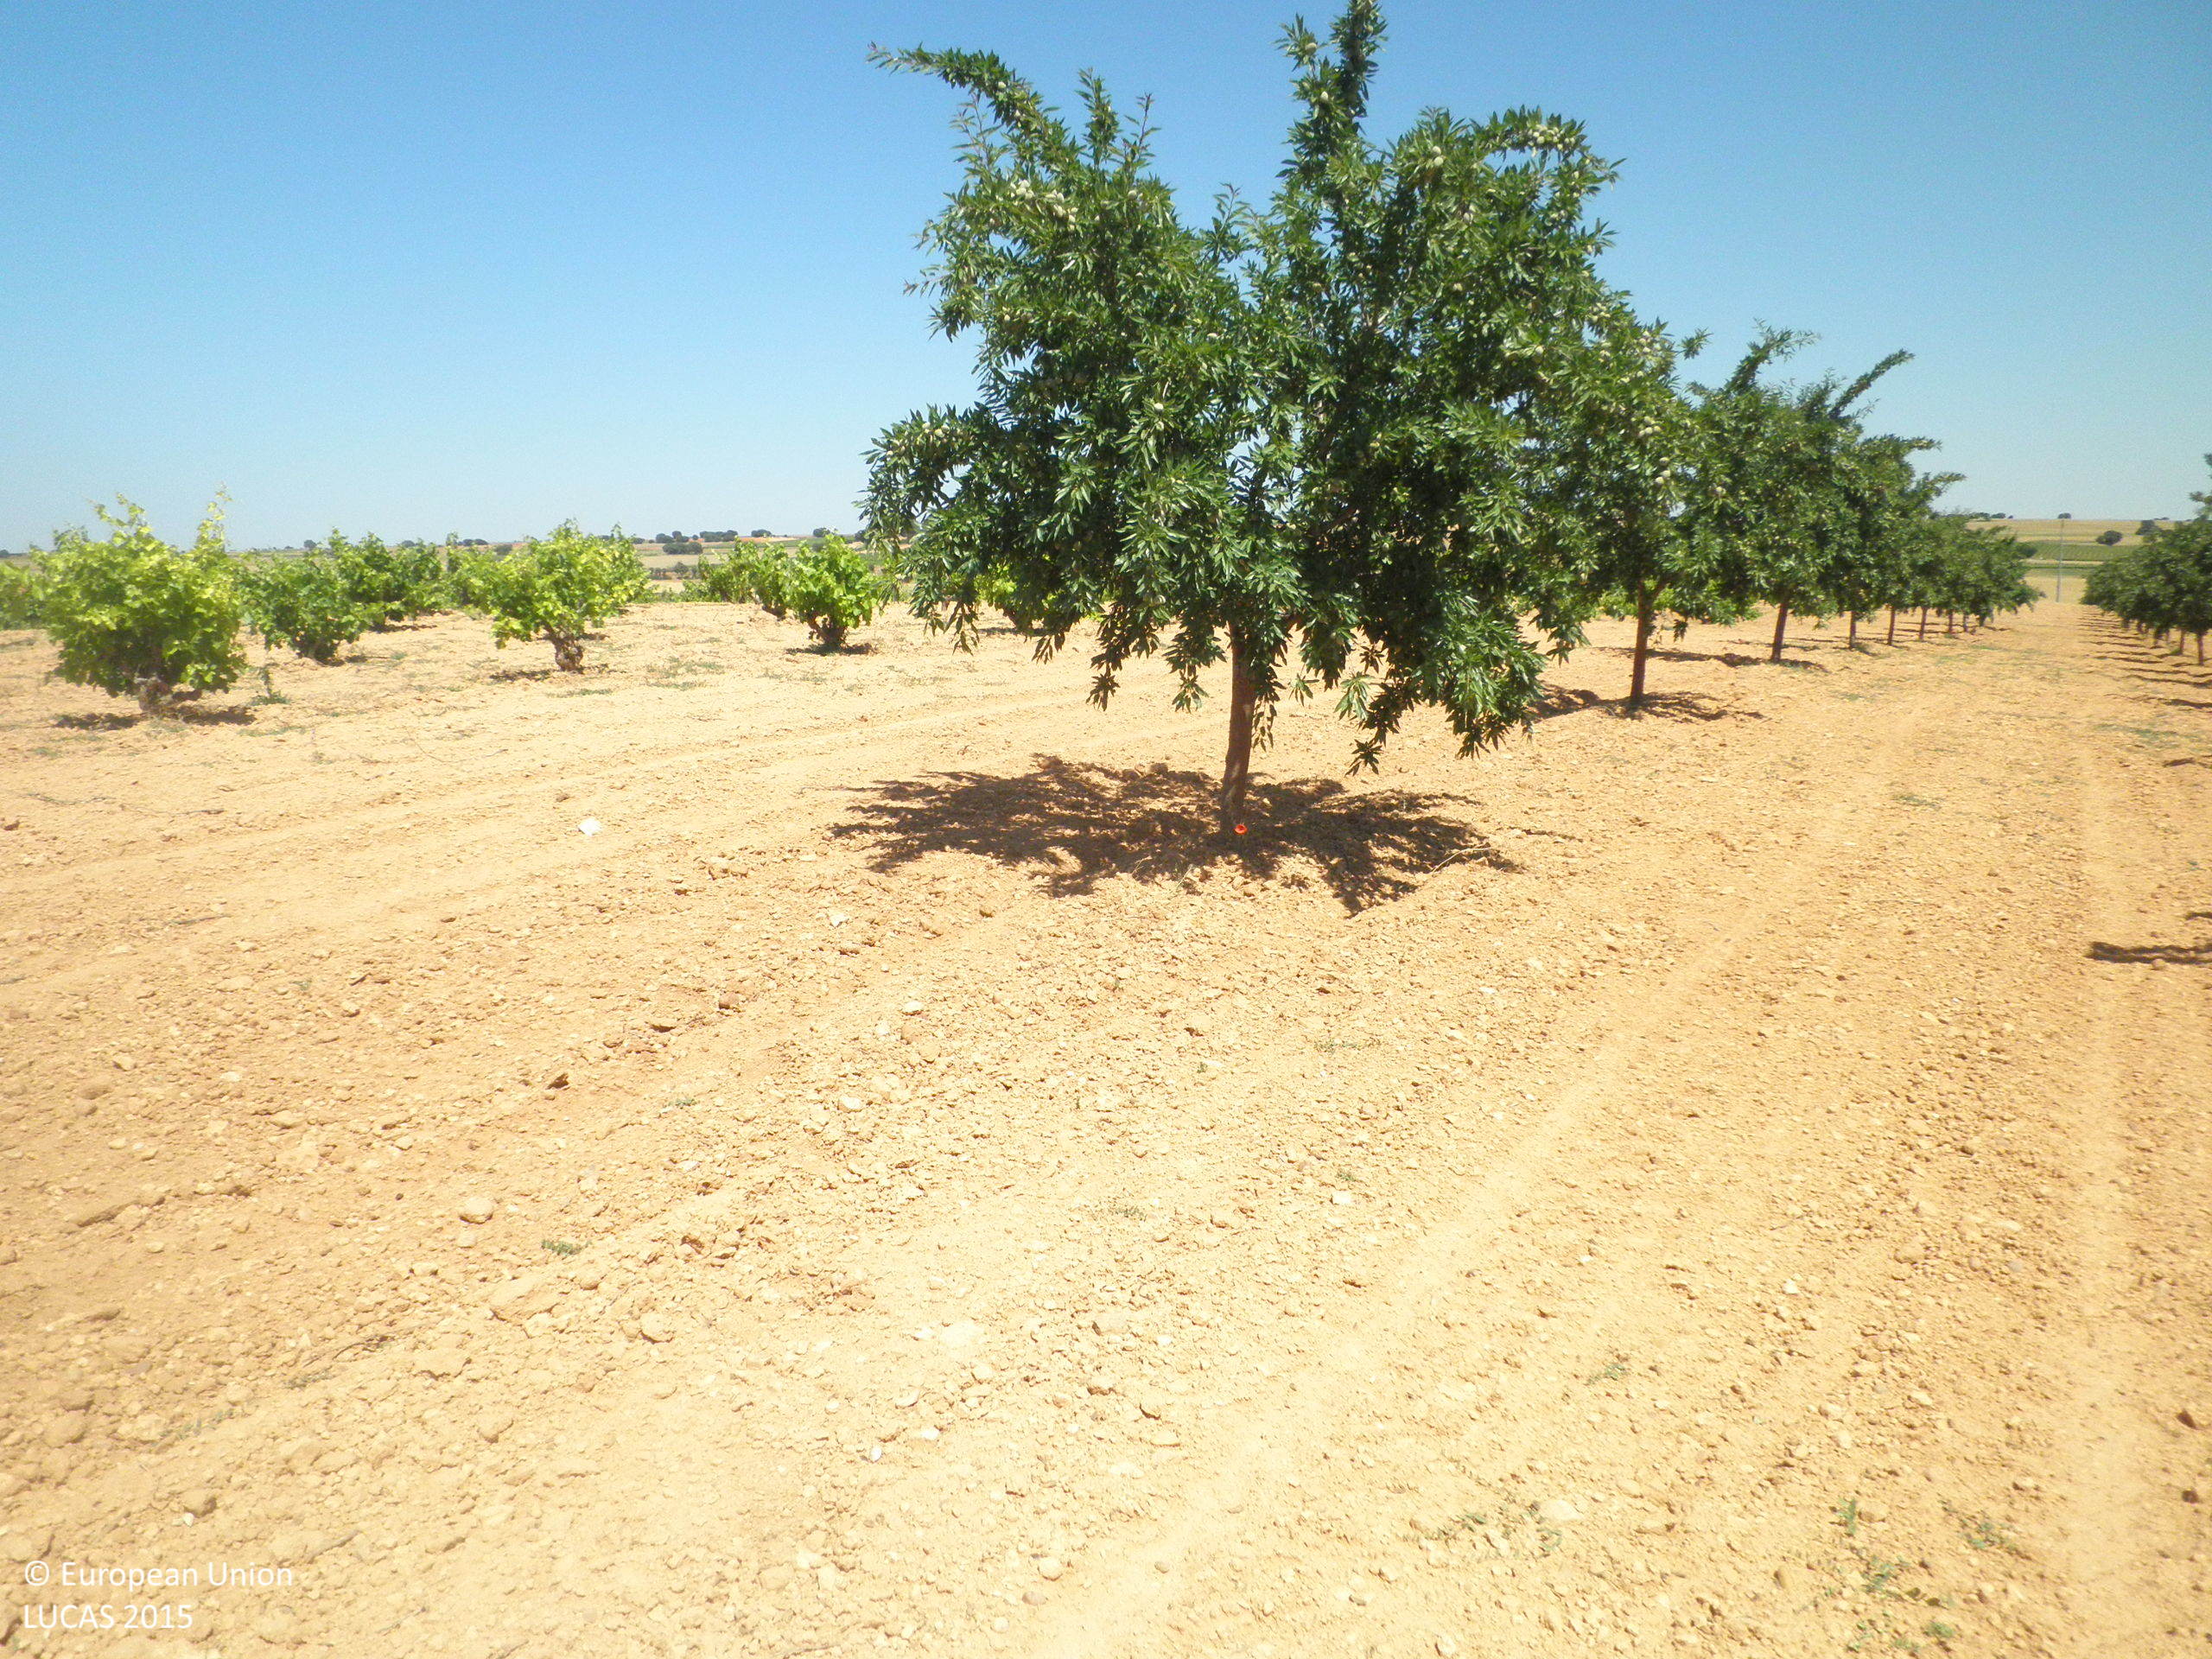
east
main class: Cropland
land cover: Nuts trees
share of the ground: 10 - 25 %
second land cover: Other bare soil
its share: > 75 %
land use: Agriculture (excluding fallow land and kitchen gardens)
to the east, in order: Nuts trees; Other bare soil; Vineyards
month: June
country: ES
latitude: 39.3866
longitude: -1.8124
